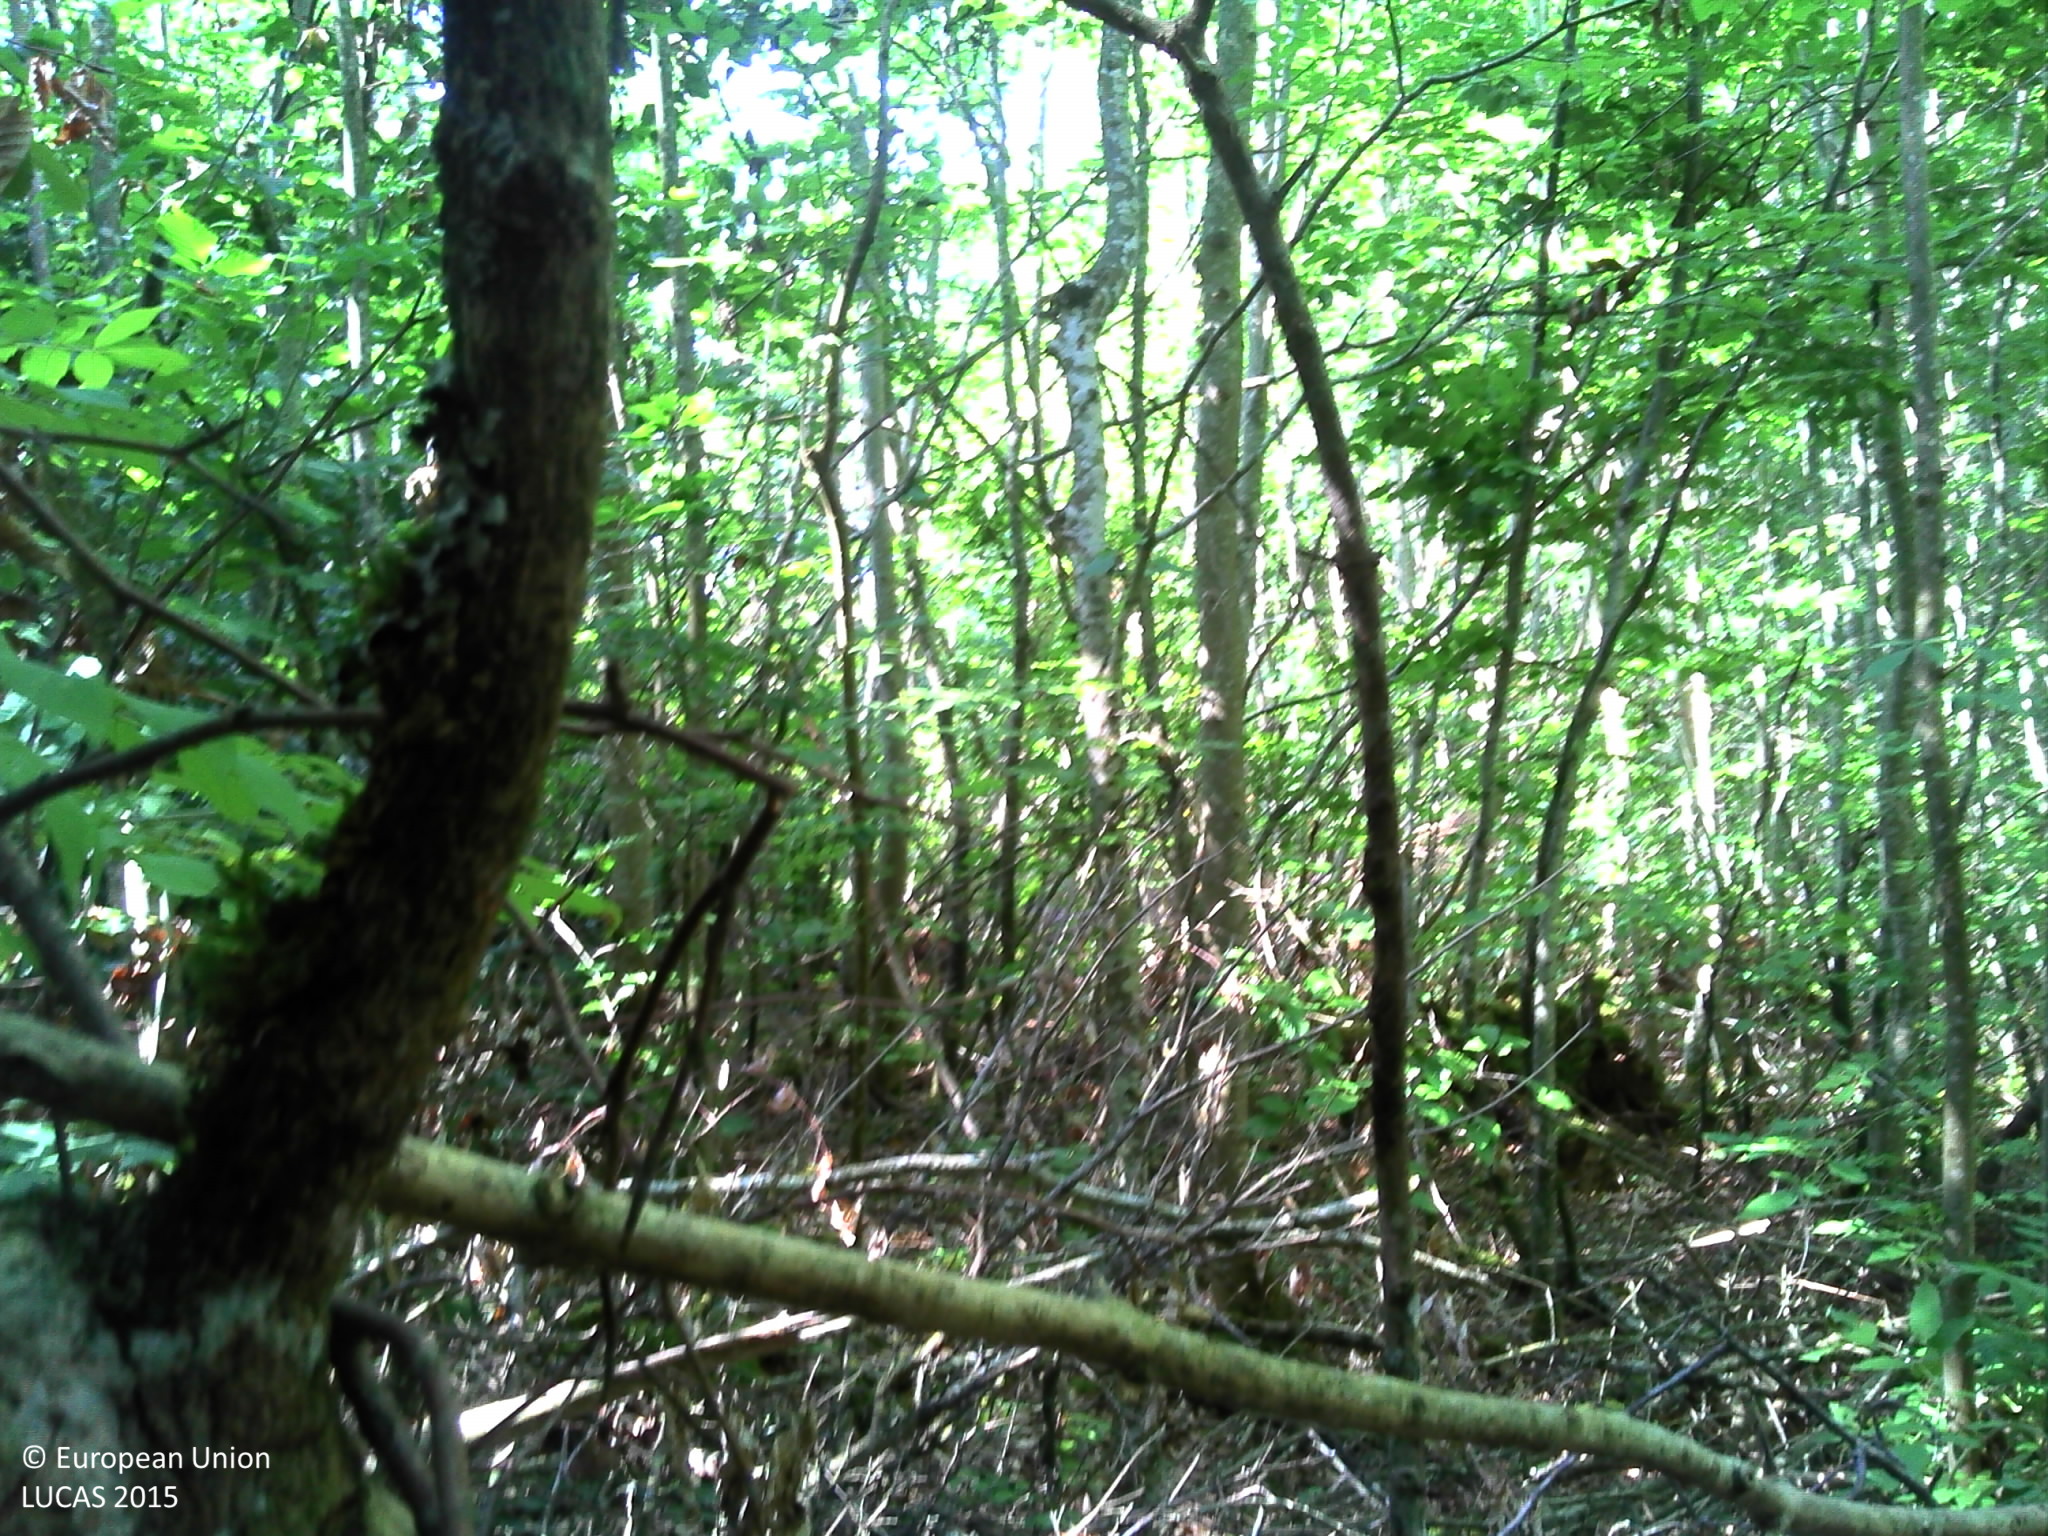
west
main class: Woodland
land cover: Broadleaved woodland
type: beech forest
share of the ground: > 75 %
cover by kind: broadleaved forest trees 90 %, herbaceous plants 5 %, consolidated bare surface 5 %
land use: Forestry
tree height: > 5 m
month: September
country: FR
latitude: 48.5635
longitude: 5.9482
